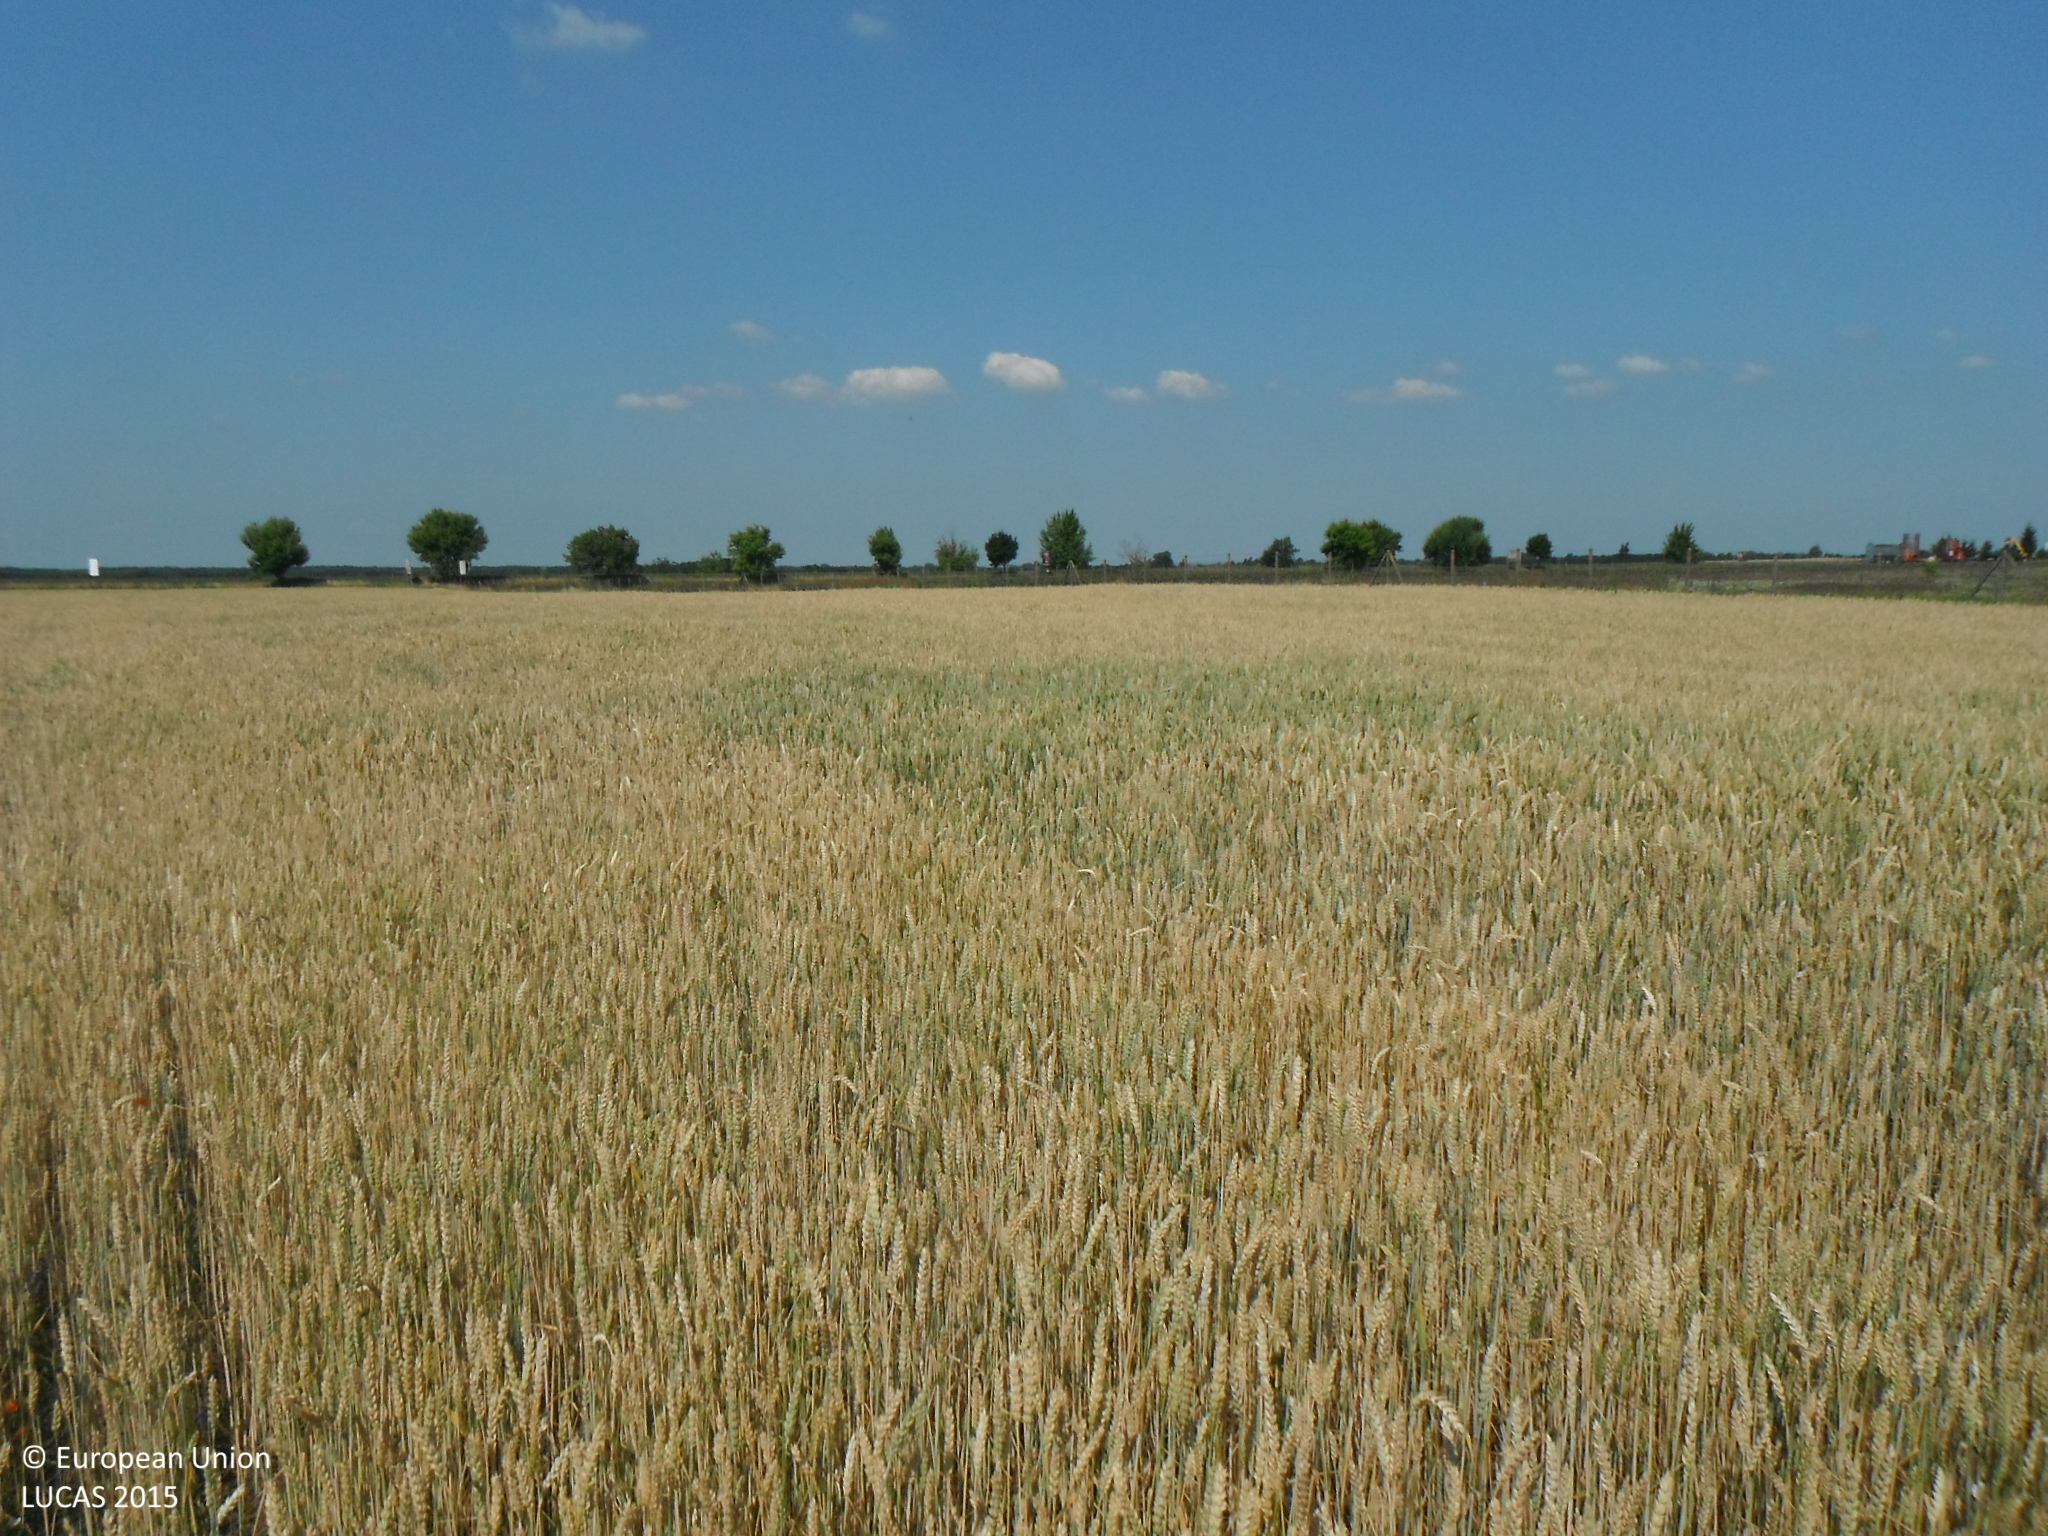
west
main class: Cropland
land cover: Common wheat
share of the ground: > 75 %
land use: Agriculture (excluding fallow land and kitchen gardens)
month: June
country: SK
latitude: 47.9543
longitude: 18.1951
